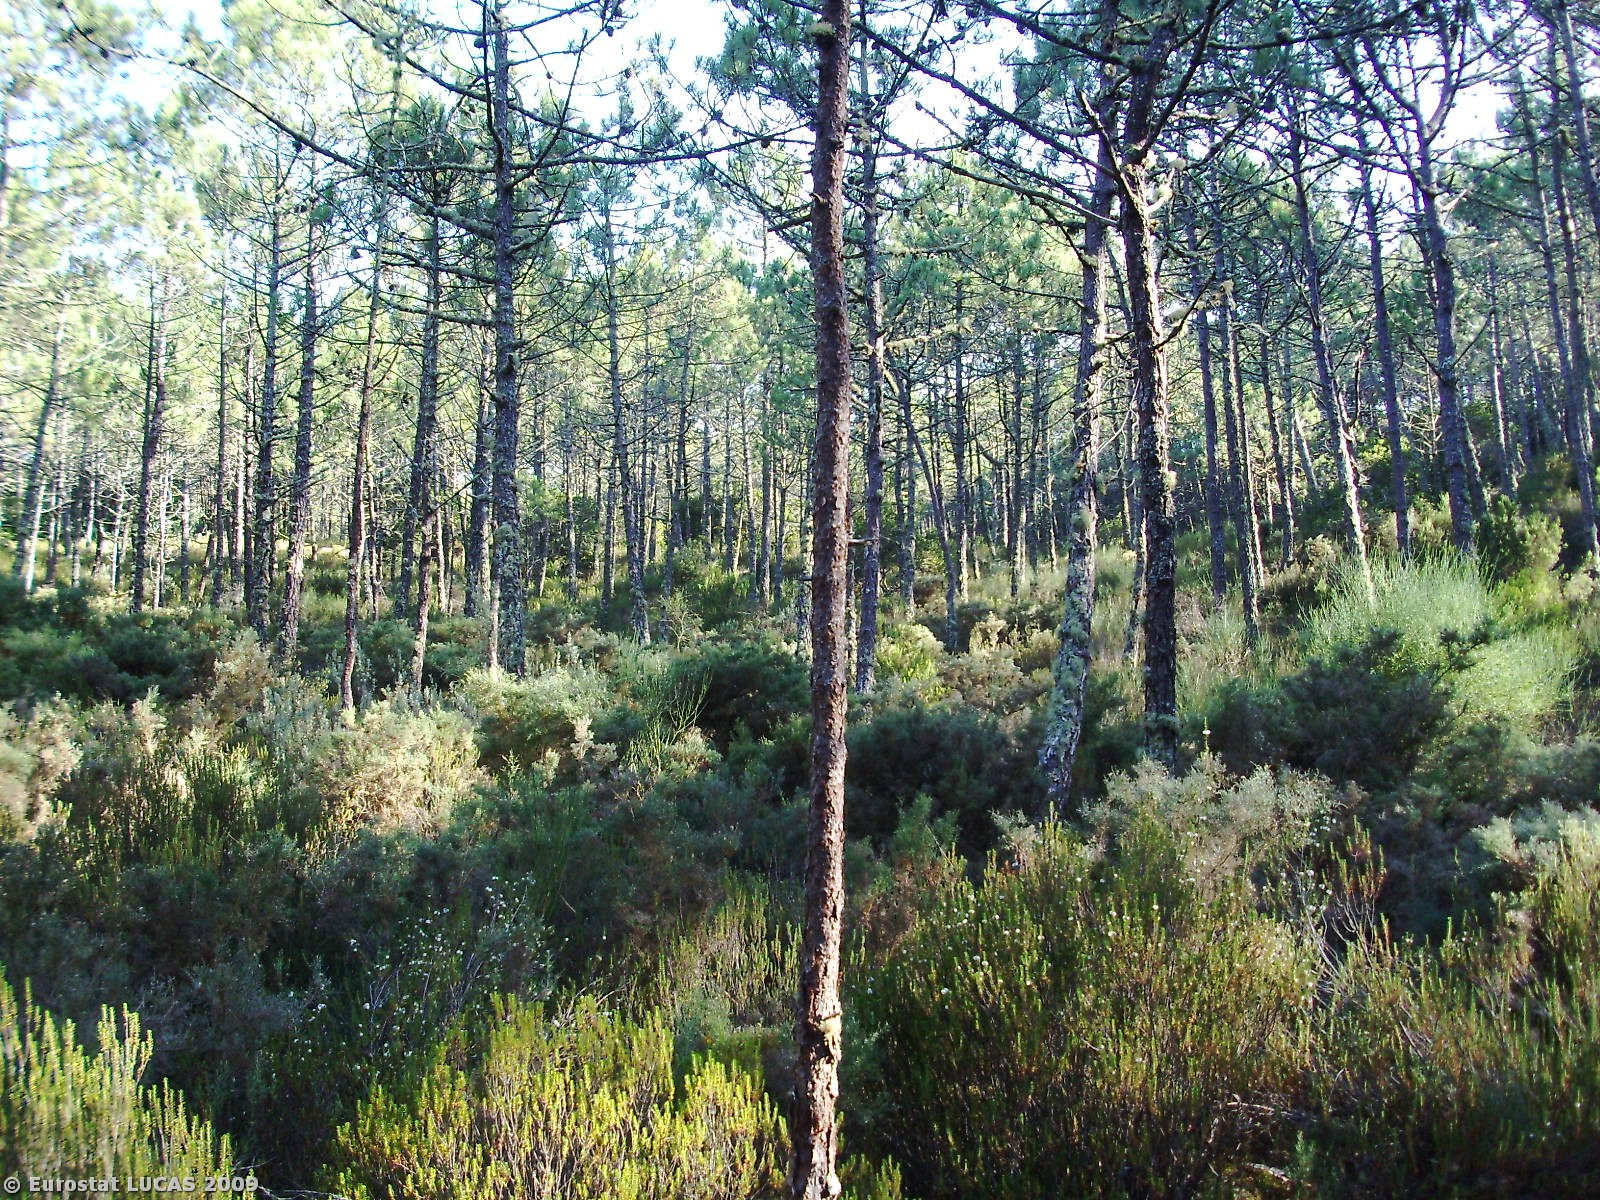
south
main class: Woodland
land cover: Coniferous woodland
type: coniferous forest of the mediterranean region
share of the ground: 50 - 75 %
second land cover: Shrubland with sparse tree cover
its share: 25 - 50 %
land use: Forestry
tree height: > 5 m
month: August
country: PT
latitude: 39.9261
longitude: -8.9189
